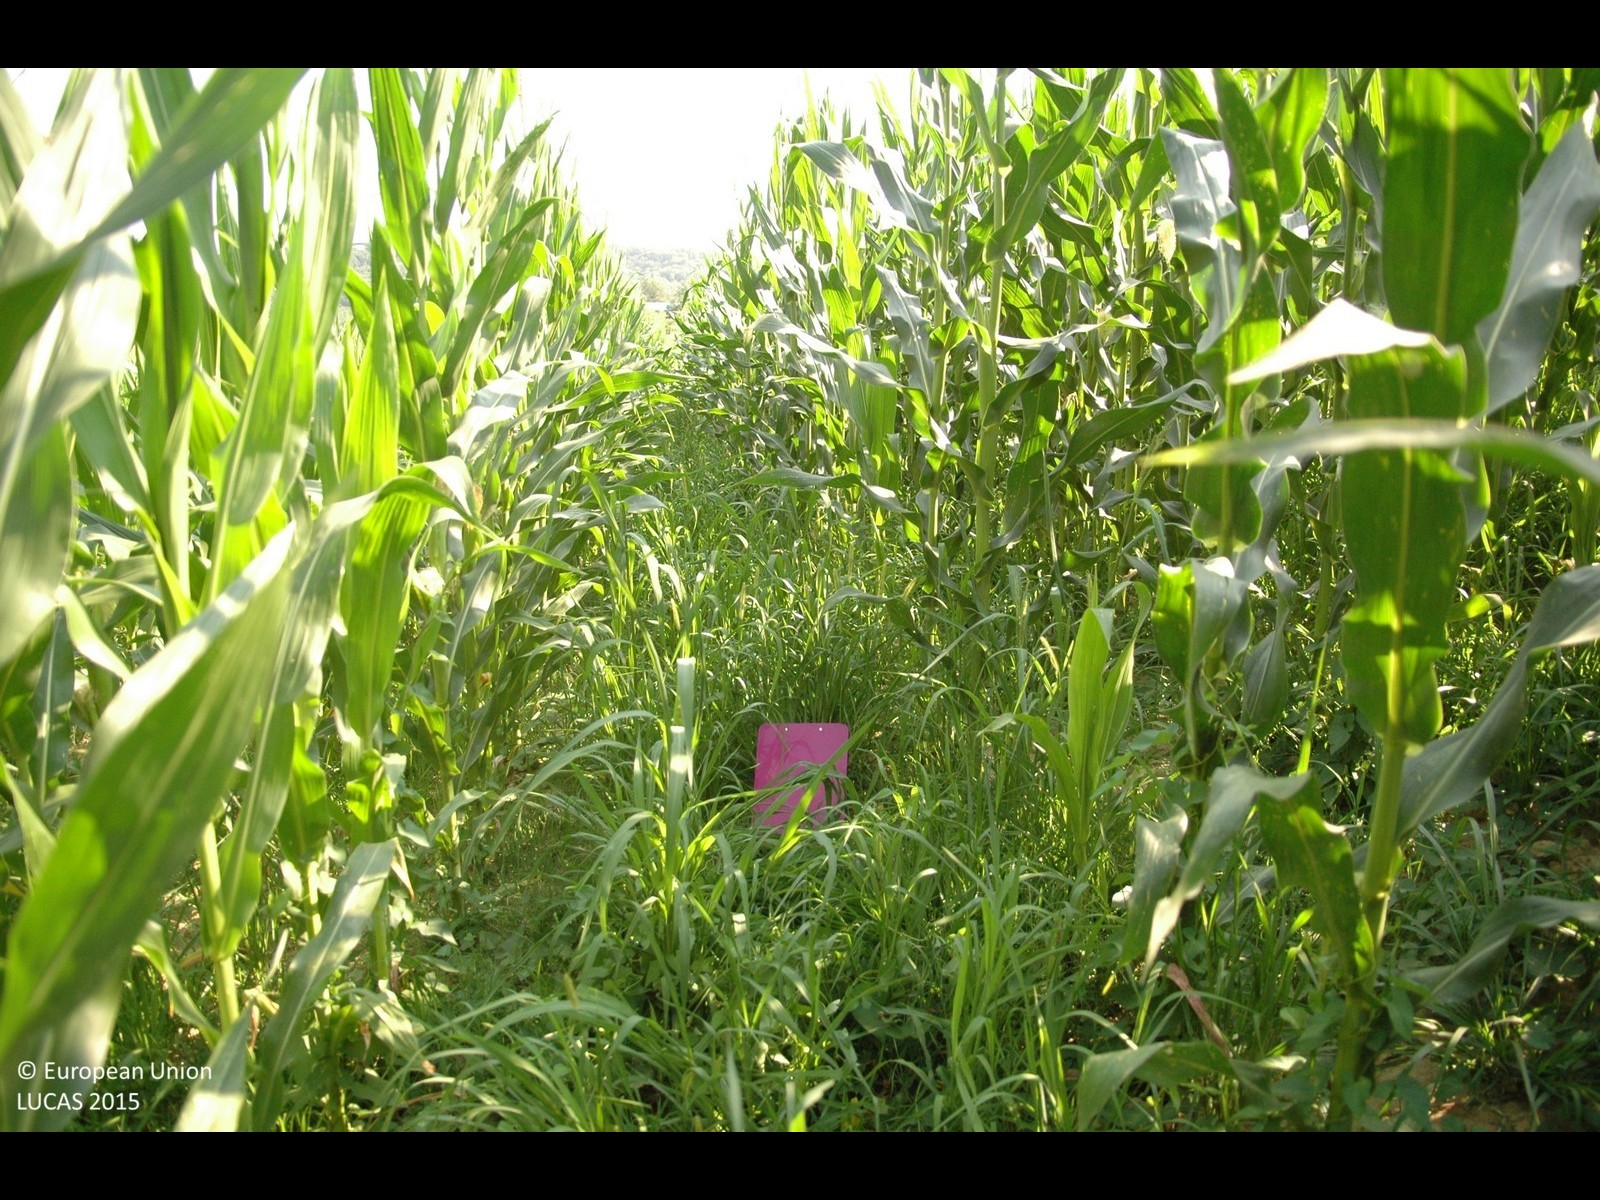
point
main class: Cropland
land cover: Maize
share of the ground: > 75 %
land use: Agriculture (excluding fallow land and kitchen gardens)
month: July
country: HR
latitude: 46.1838
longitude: 16.5948
